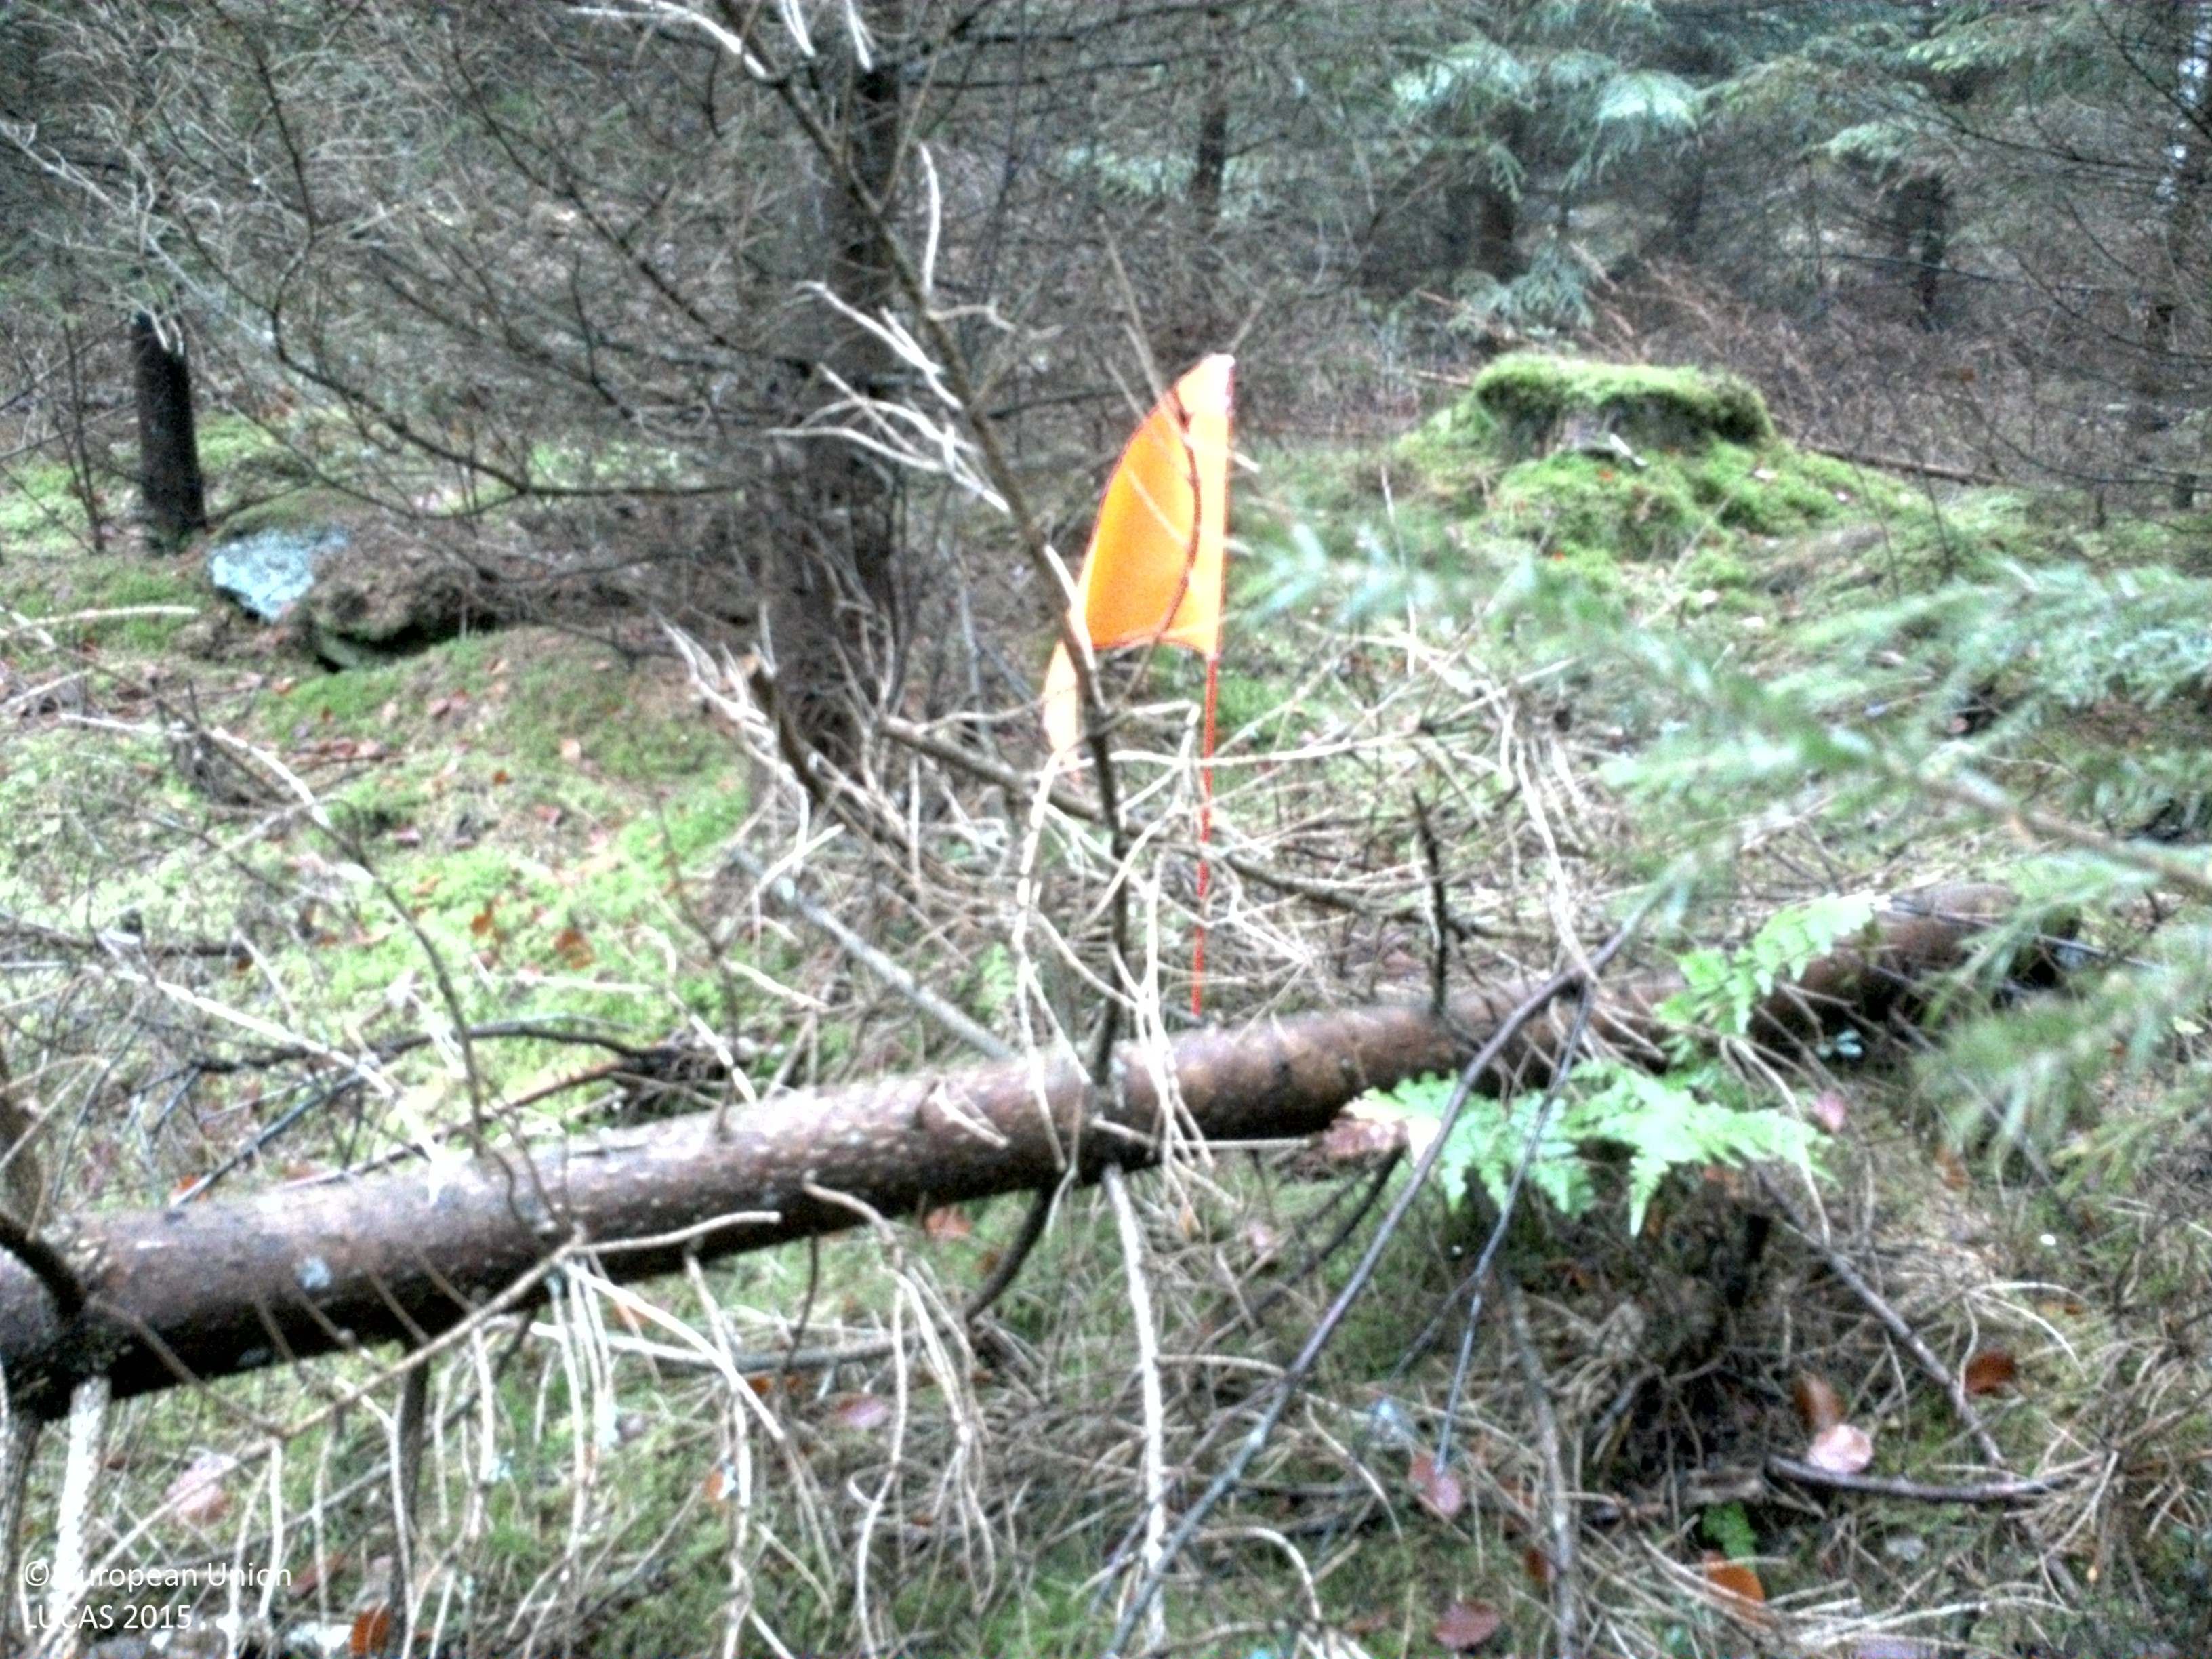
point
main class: Woodland
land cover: Spruce dominated coniferous woodland
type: hemiboreal forest and nemoral coniferous forest and mixed broadleaved-coniferous forest
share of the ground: > 75 %
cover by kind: coniferous forest trees 85 %, lichens and mosses 10 %, unconsolidated bare surface 5 %
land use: Forestry
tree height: > 5 m
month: November
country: SE
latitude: 56.2026
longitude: 13.1729
